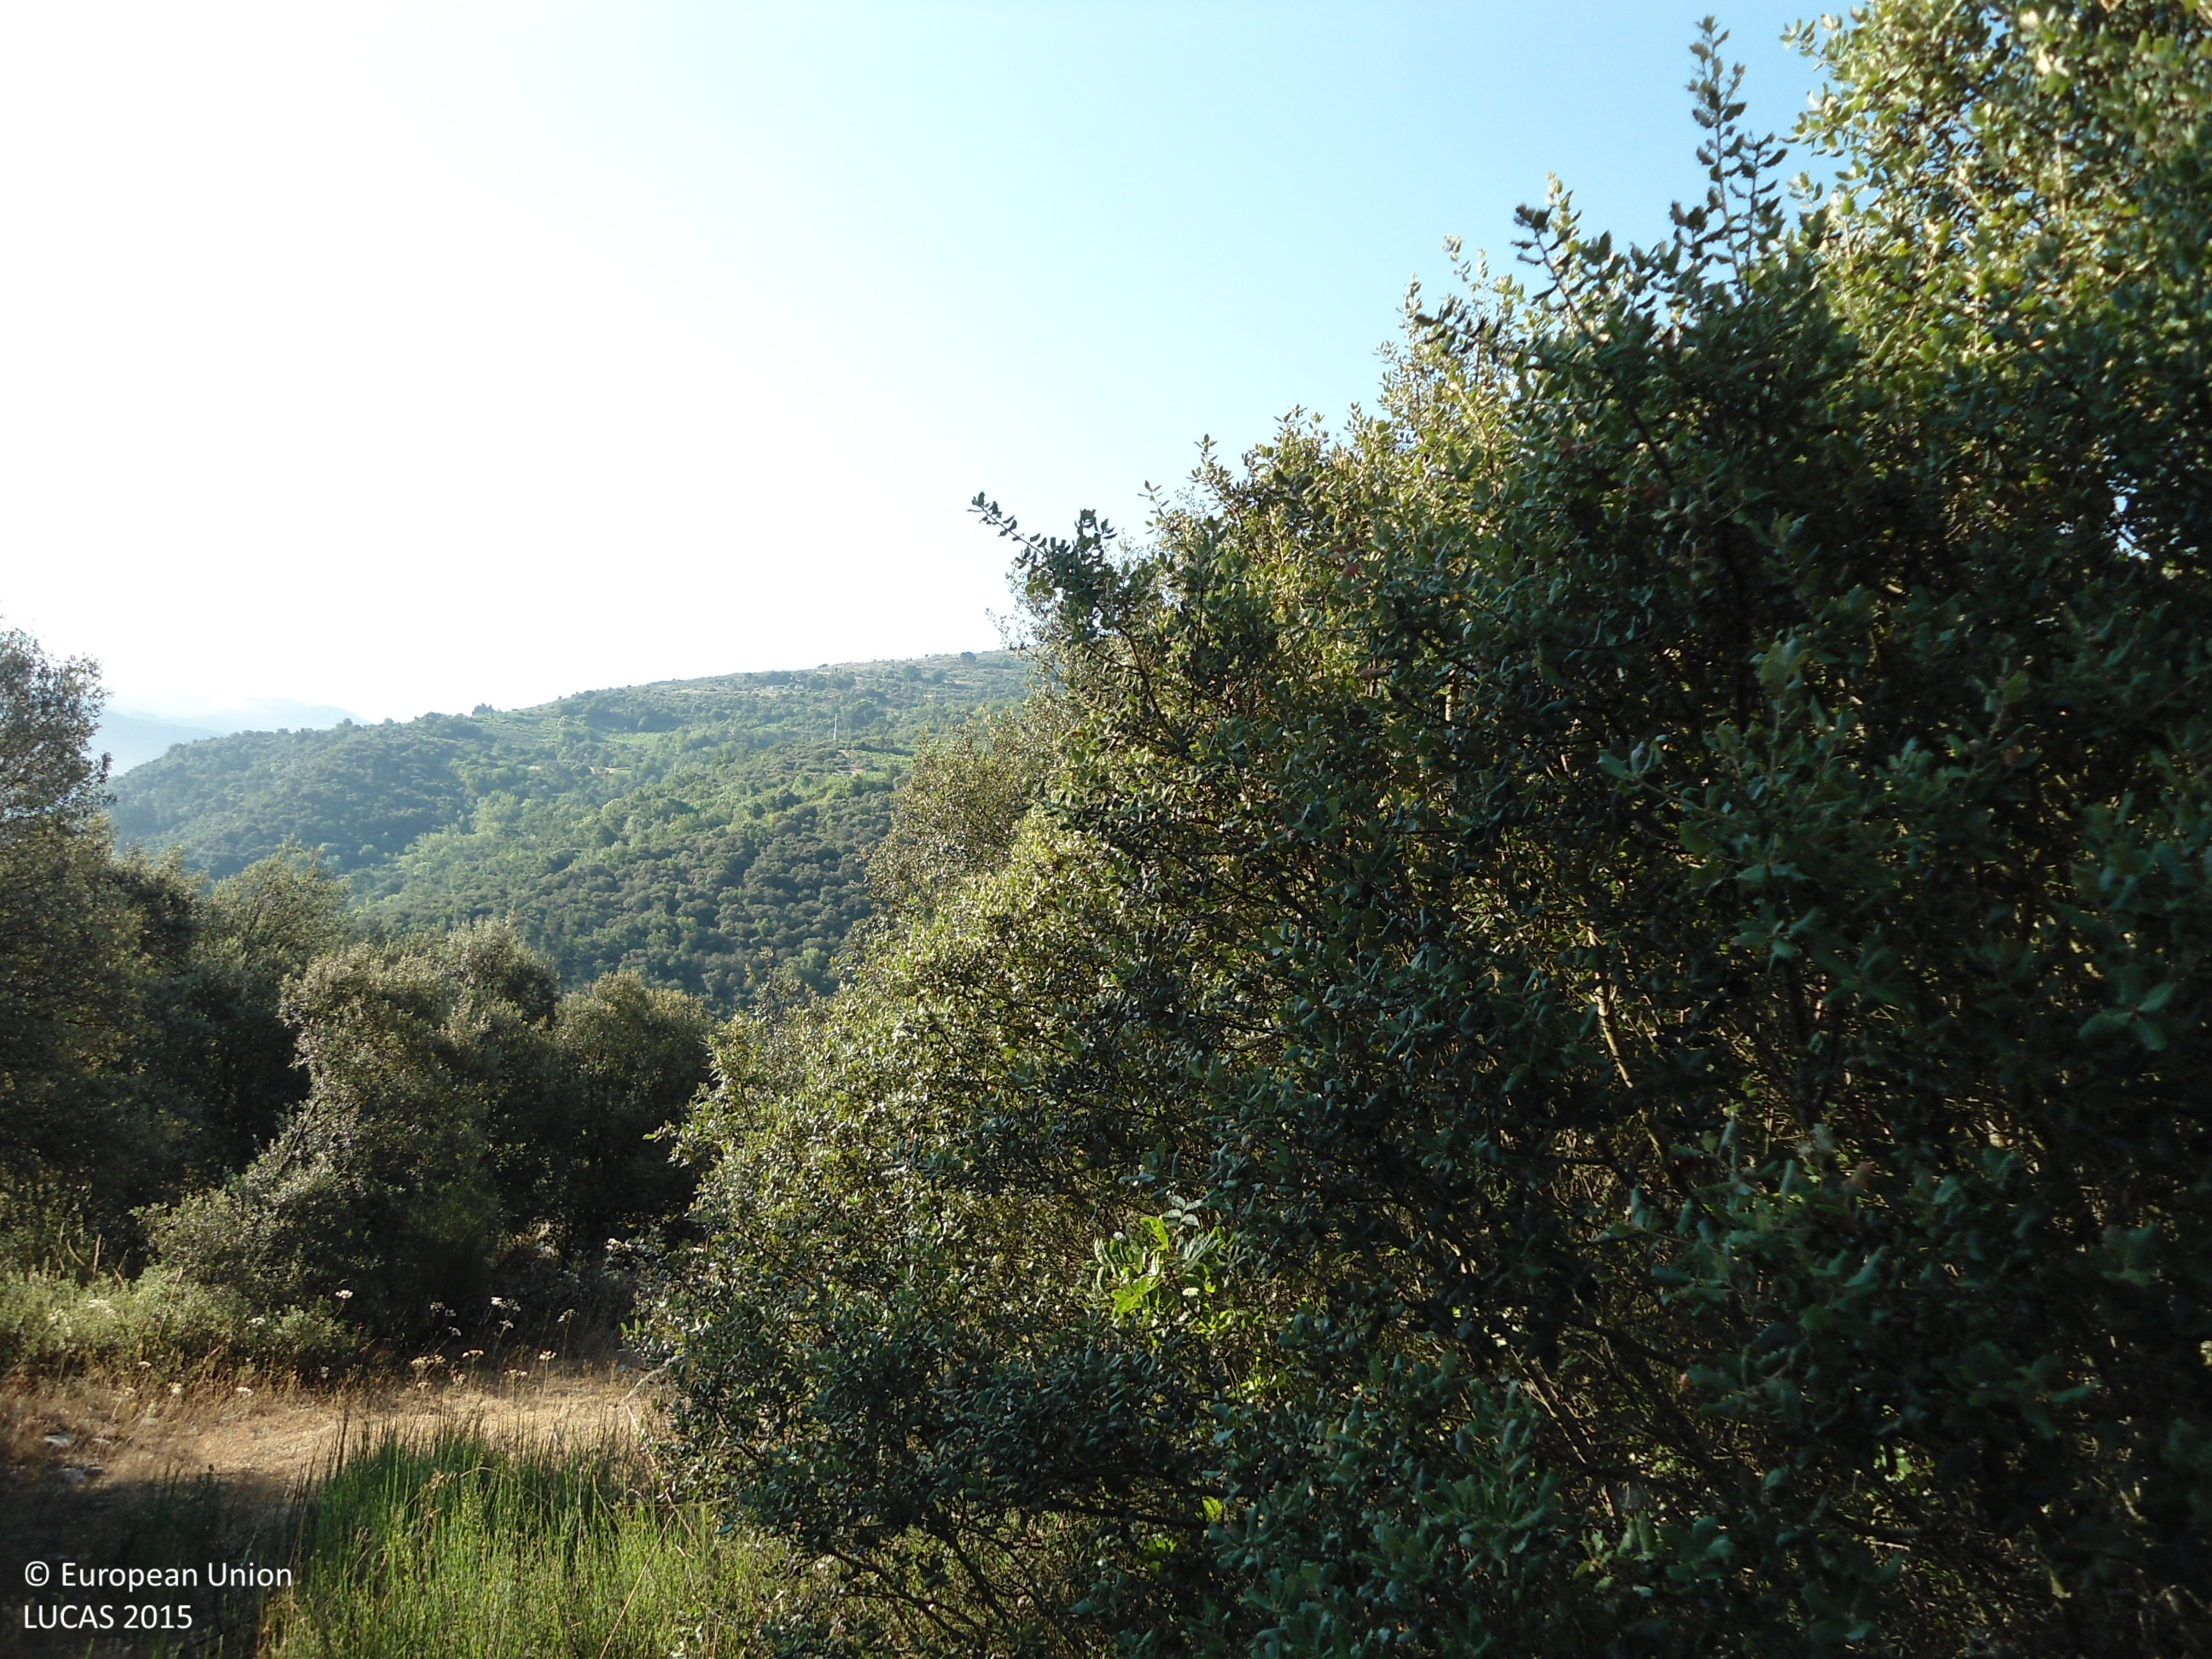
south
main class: Shrubland
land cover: Shrubland with sparse tree cover
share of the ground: > 75 %
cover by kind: shrubs 95 %, broadleaved forest trees 5 %
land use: Semi-natural and natural areas not in use
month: June
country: ES
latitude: 42.3860
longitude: -6.8742
